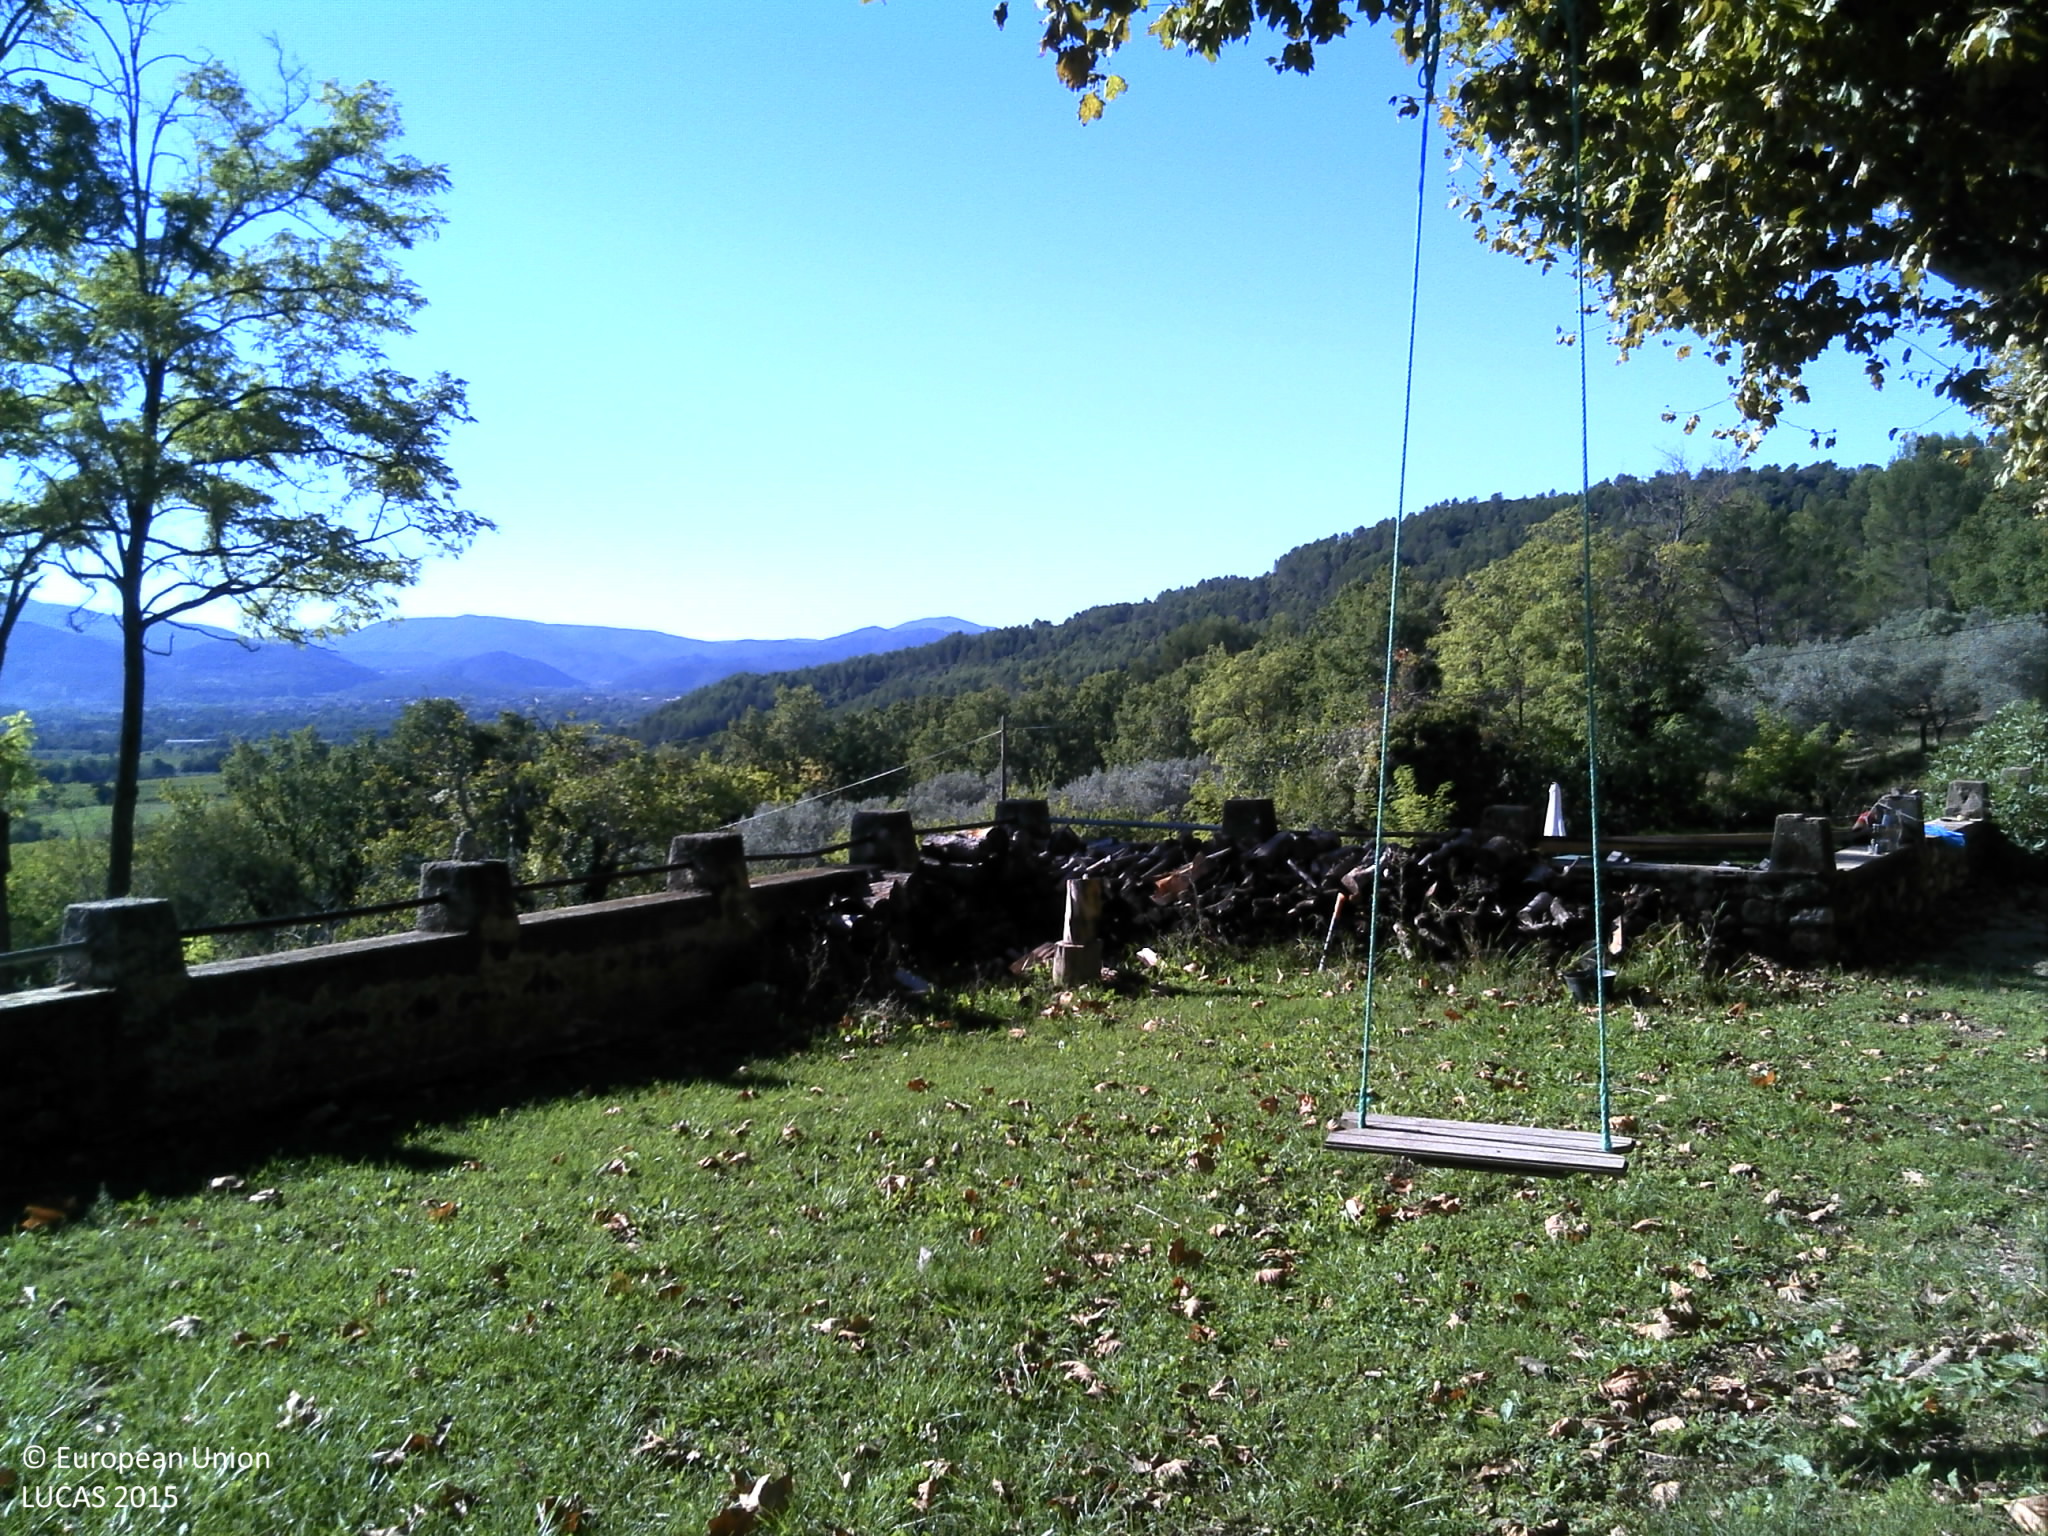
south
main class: Woodland
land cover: Broadleaved woodland
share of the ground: 50 - 75 %
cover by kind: broadleaved forest trees 50 %, herbaceous plants 50 %
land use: Residential
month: October
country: FR
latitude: 43.5170
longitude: 6.5569
